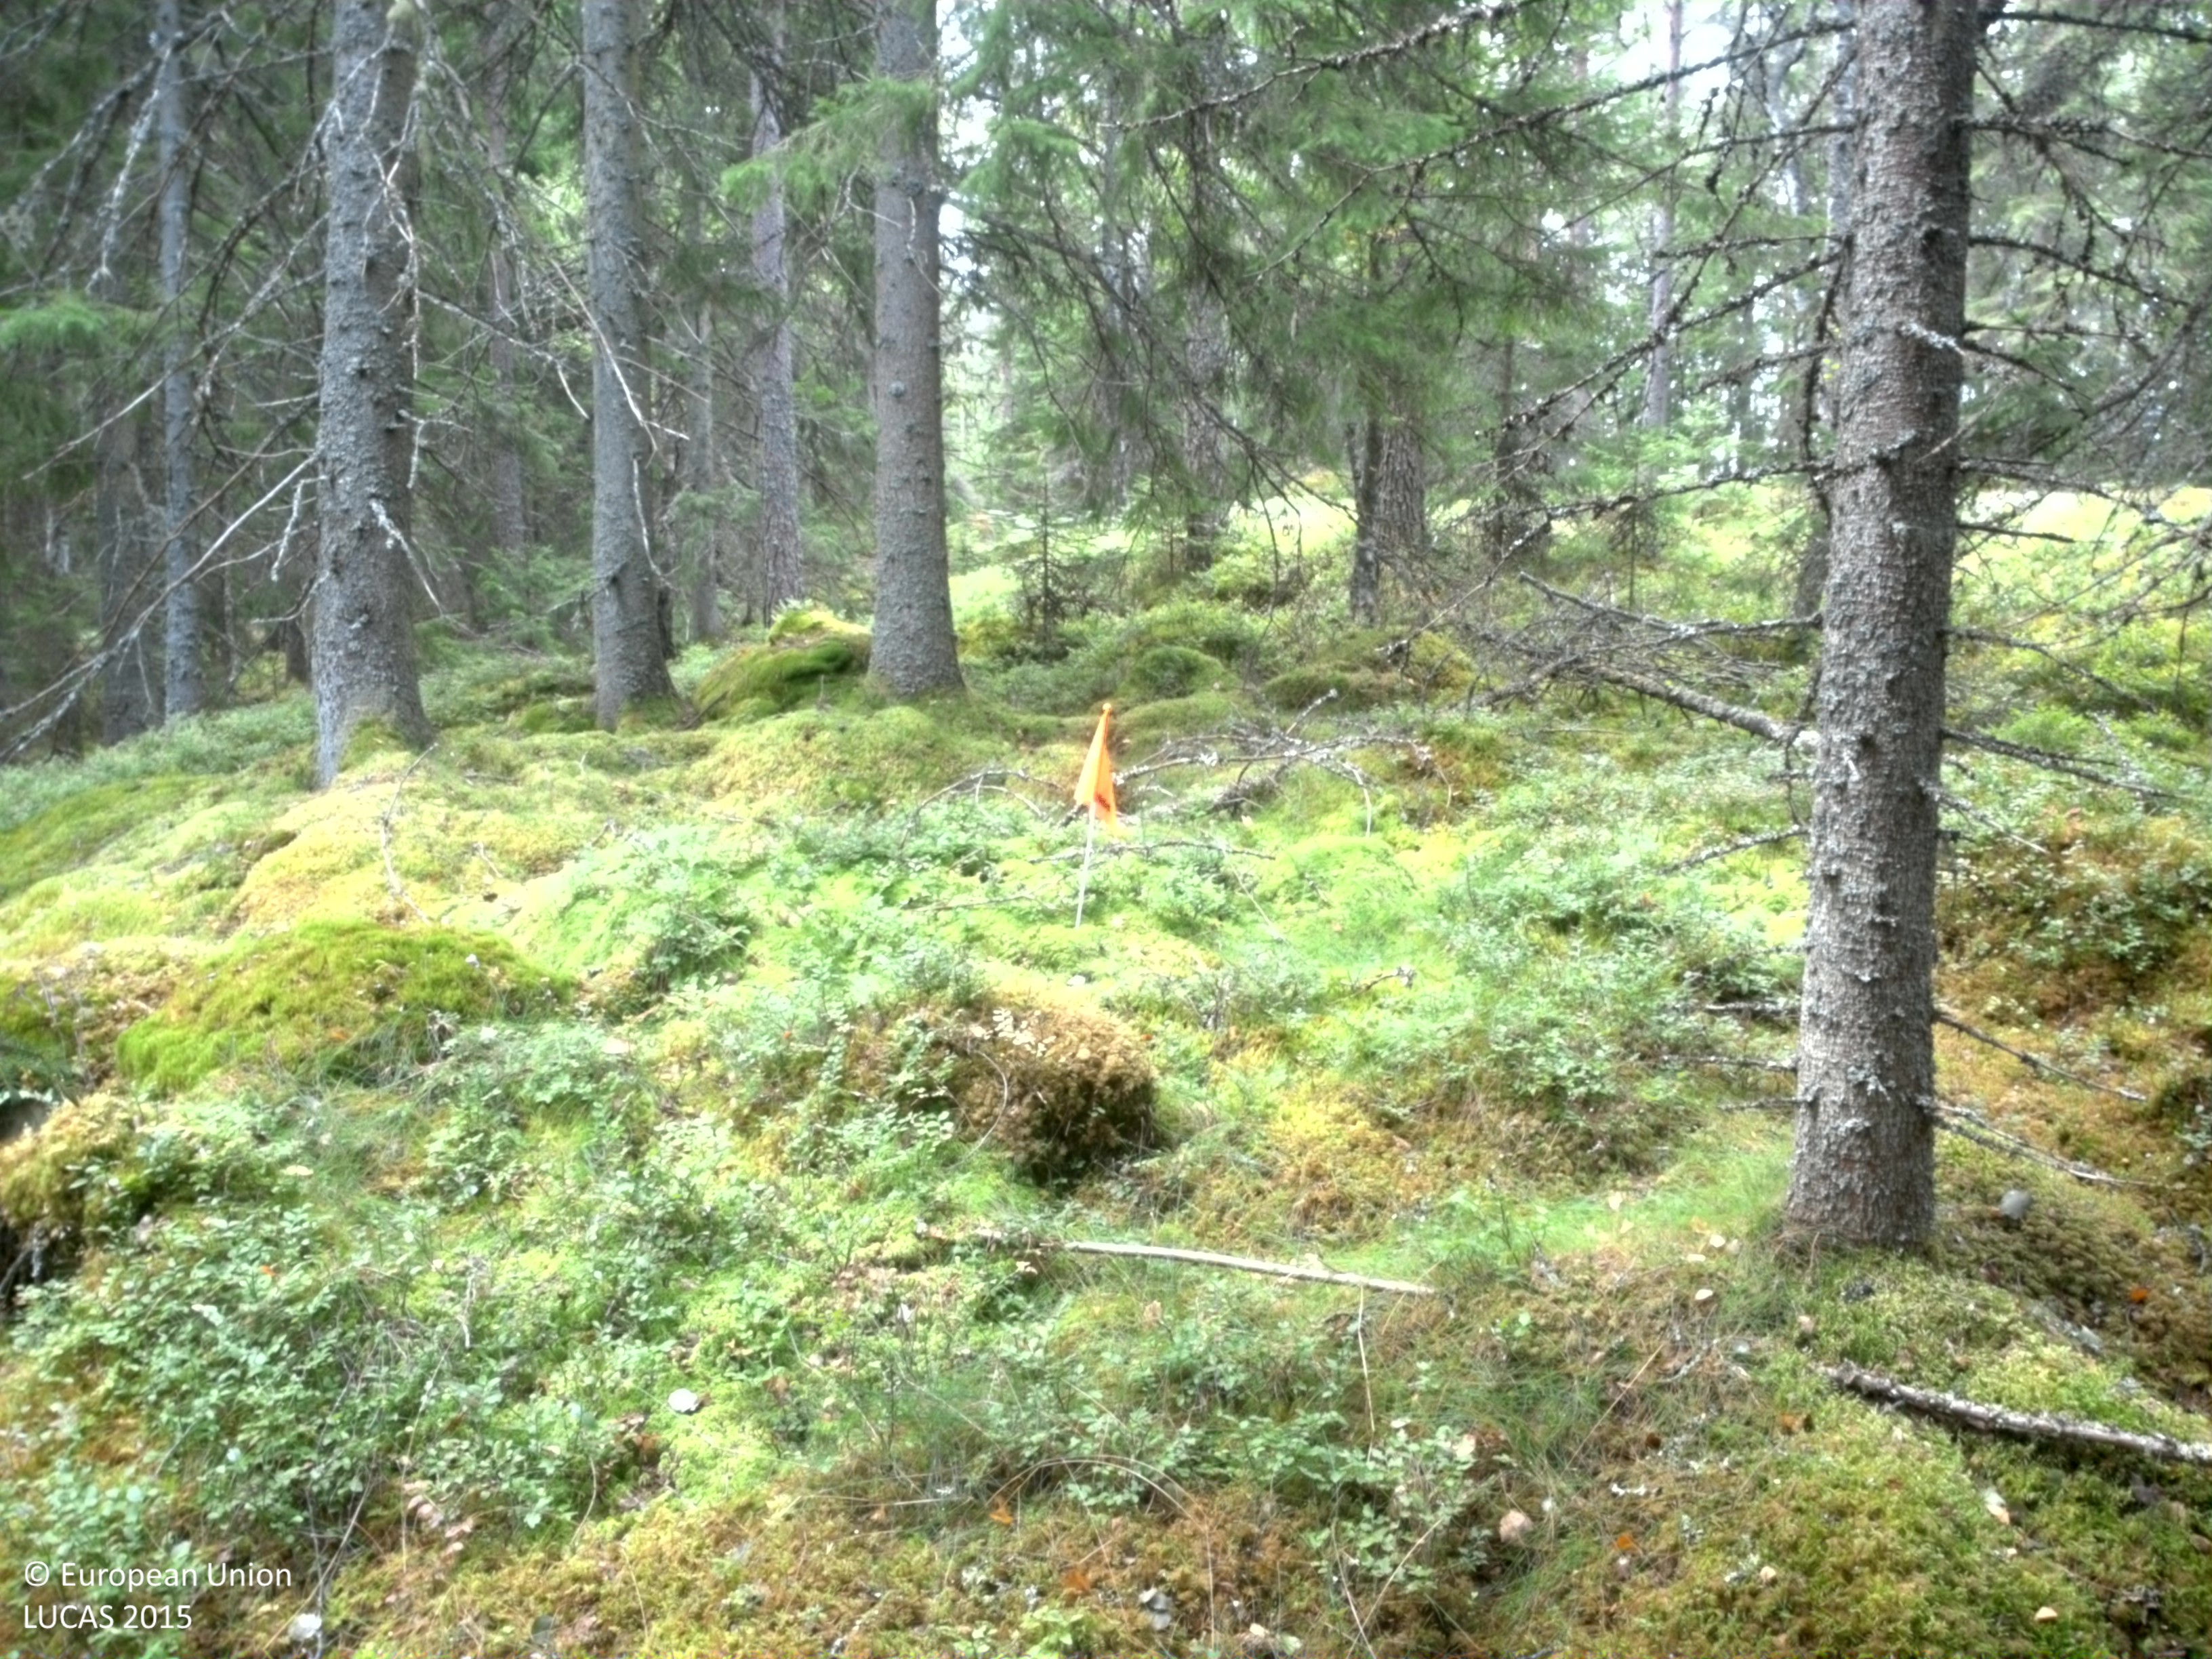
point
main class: Woodland
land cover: Spruce dominated coniferous woodland
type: boreal forest
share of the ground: 50 - 75 %
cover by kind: coniferous forest trees 50 %, lichens and mosses 35 %, shrubs 10 %, broadleaved forest trees 5 %
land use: Forestry
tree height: > 5 m
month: August
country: SE
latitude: 57.8193
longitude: 13.9510
